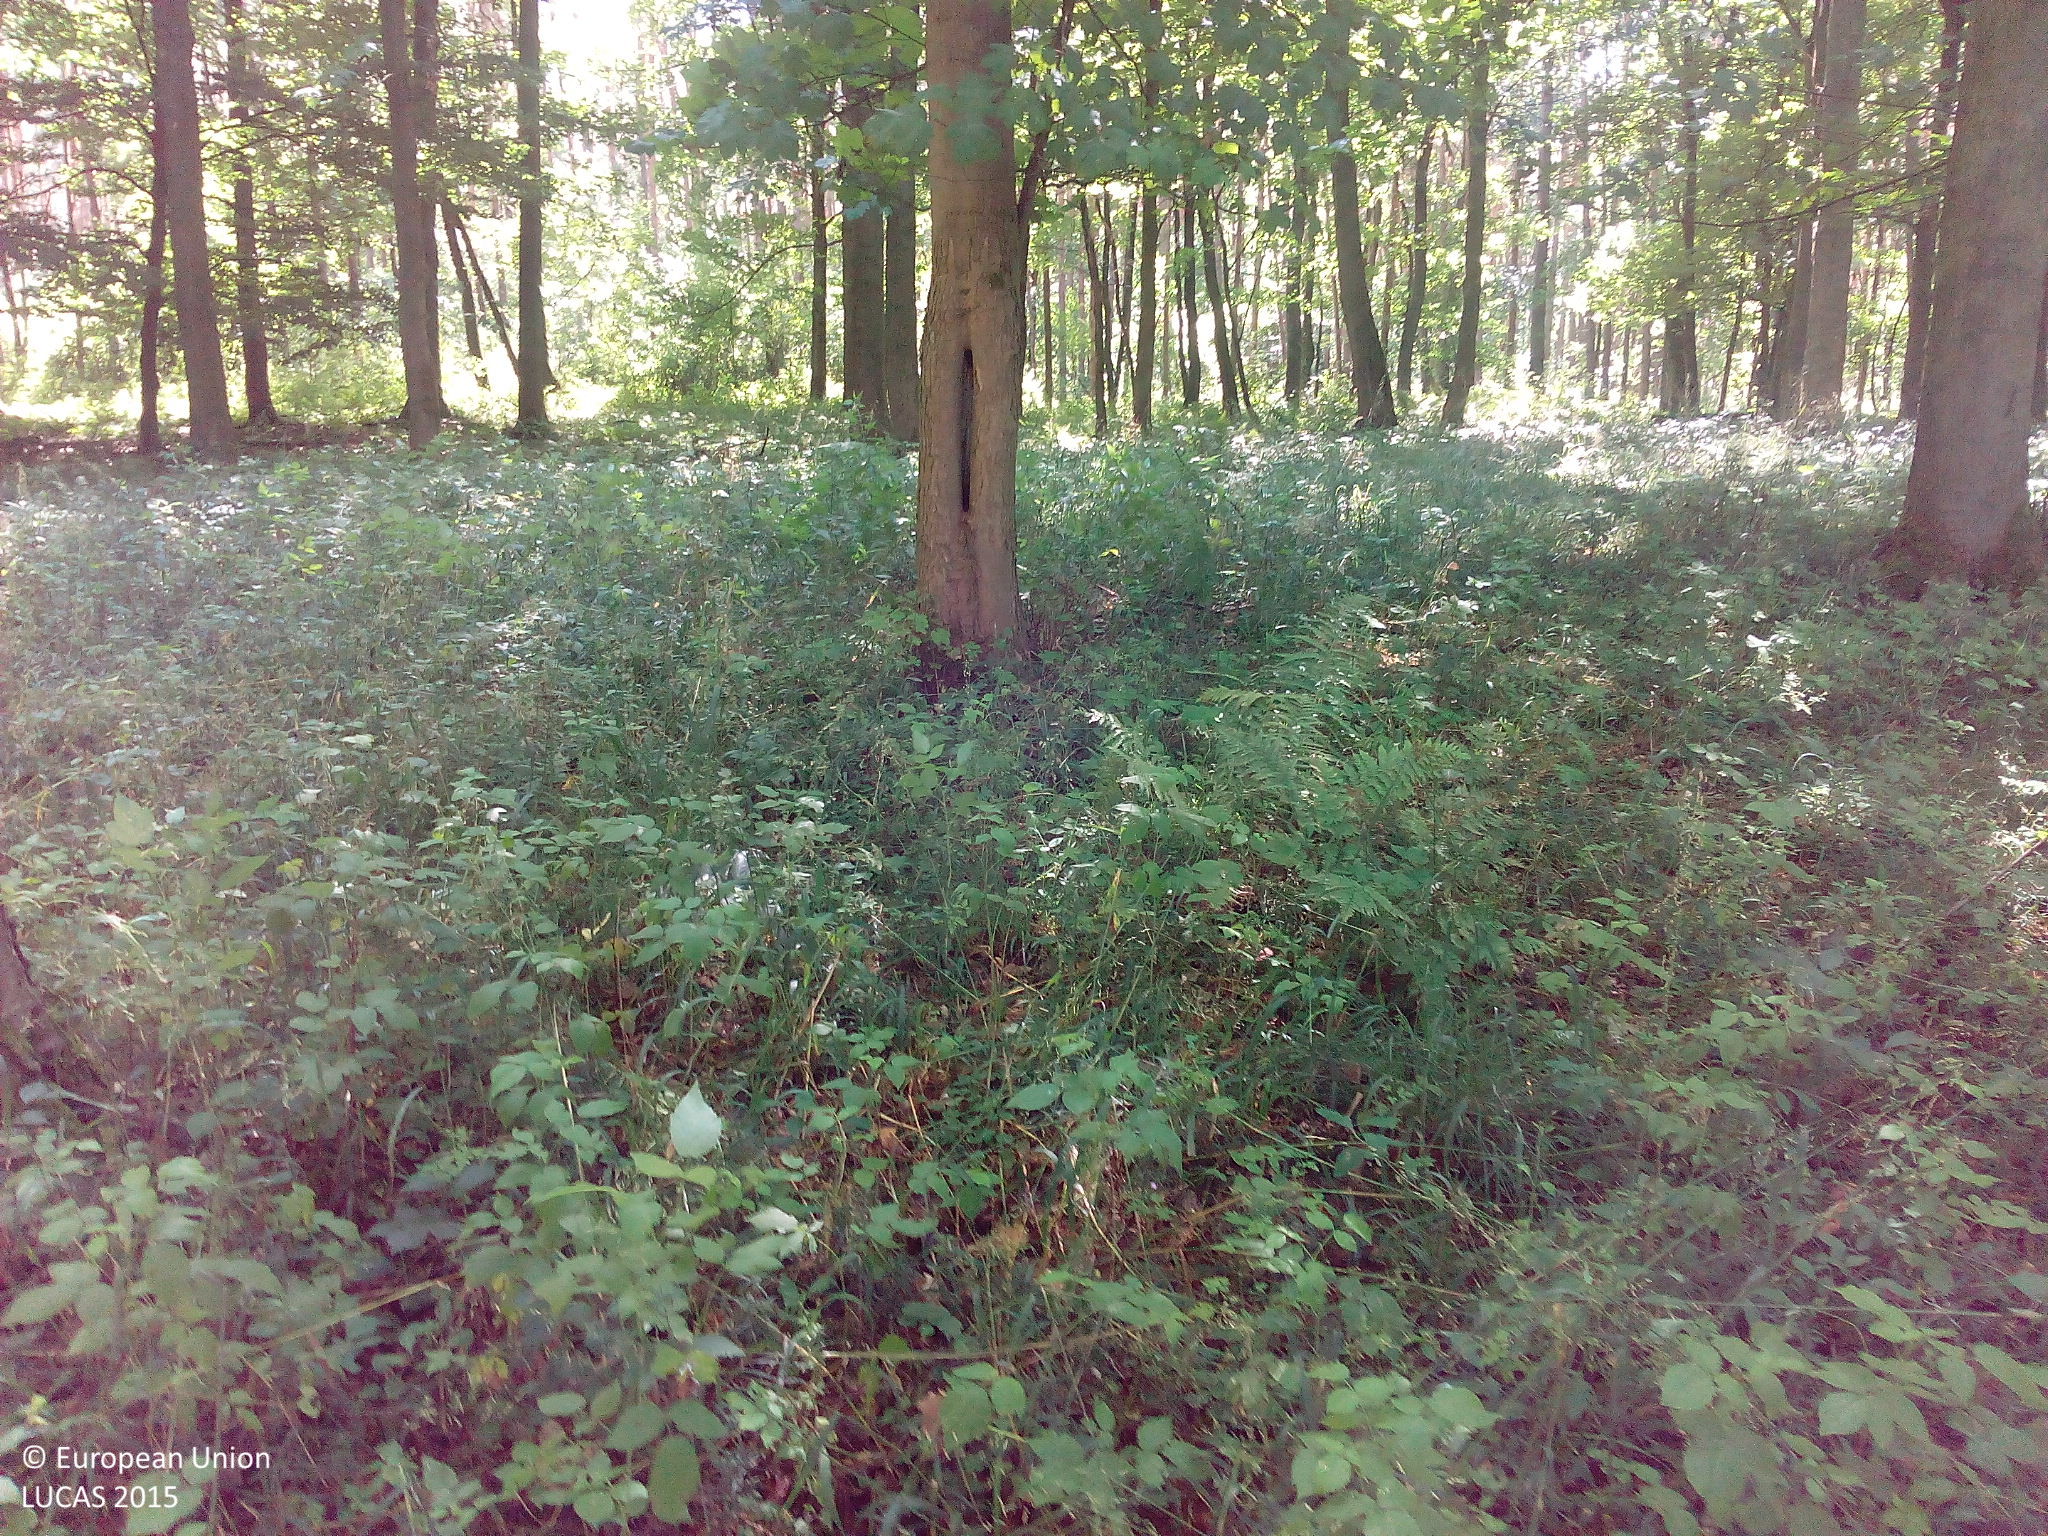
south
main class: Woodland
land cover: Broadleaved woodland
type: mesophytic deciduous forest
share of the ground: > 75 %
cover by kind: broadleaved forest trees 90 %, herbaceous plants 10 %
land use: Forestry
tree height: > 5 m
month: August
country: DE
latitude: 53.4490
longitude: 12.4537
